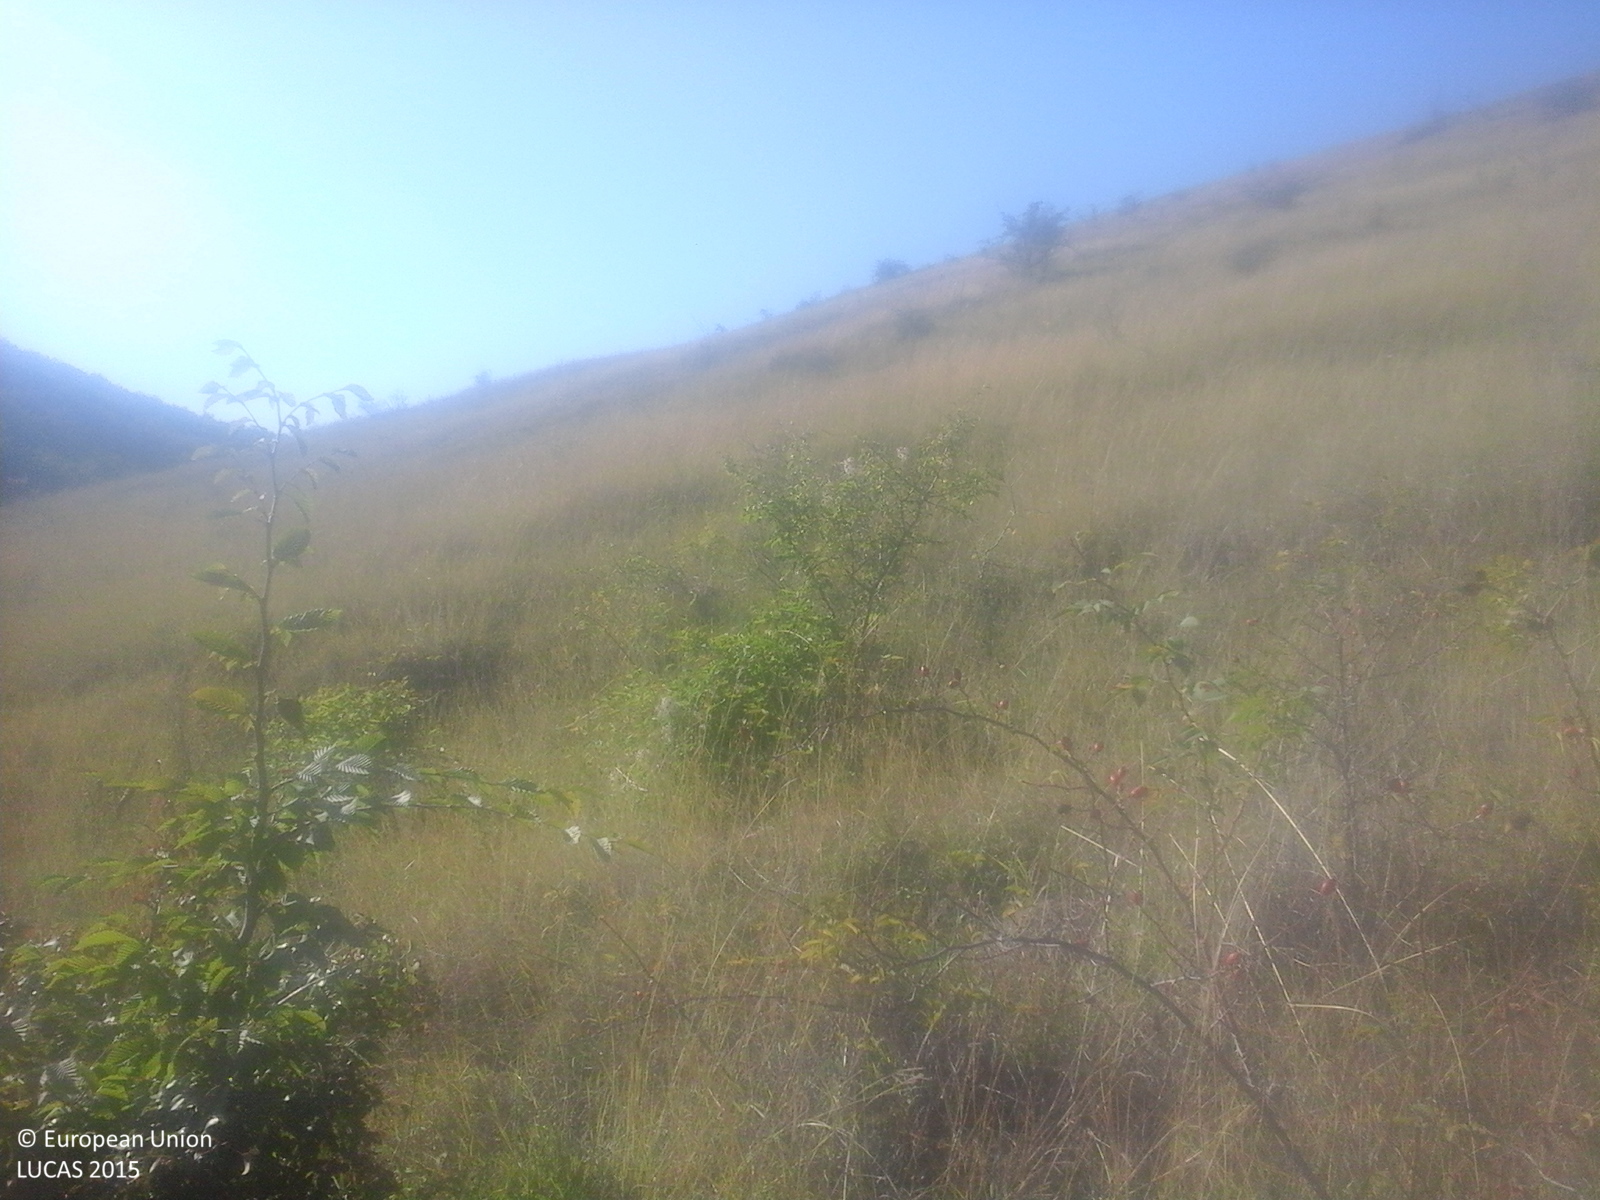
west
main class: Grassland
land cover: Grassland with sparse tree/shrub cover
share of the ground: > 75 %
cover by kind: herbaceous plants 85 %, shrubs 10 %, broadleaved forest trees 5 %
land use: Agriculture (excluding fallow land and kitchen gardens)
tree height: < 5 m
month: October
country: RO
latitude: 46.4603
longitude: 23.6243
